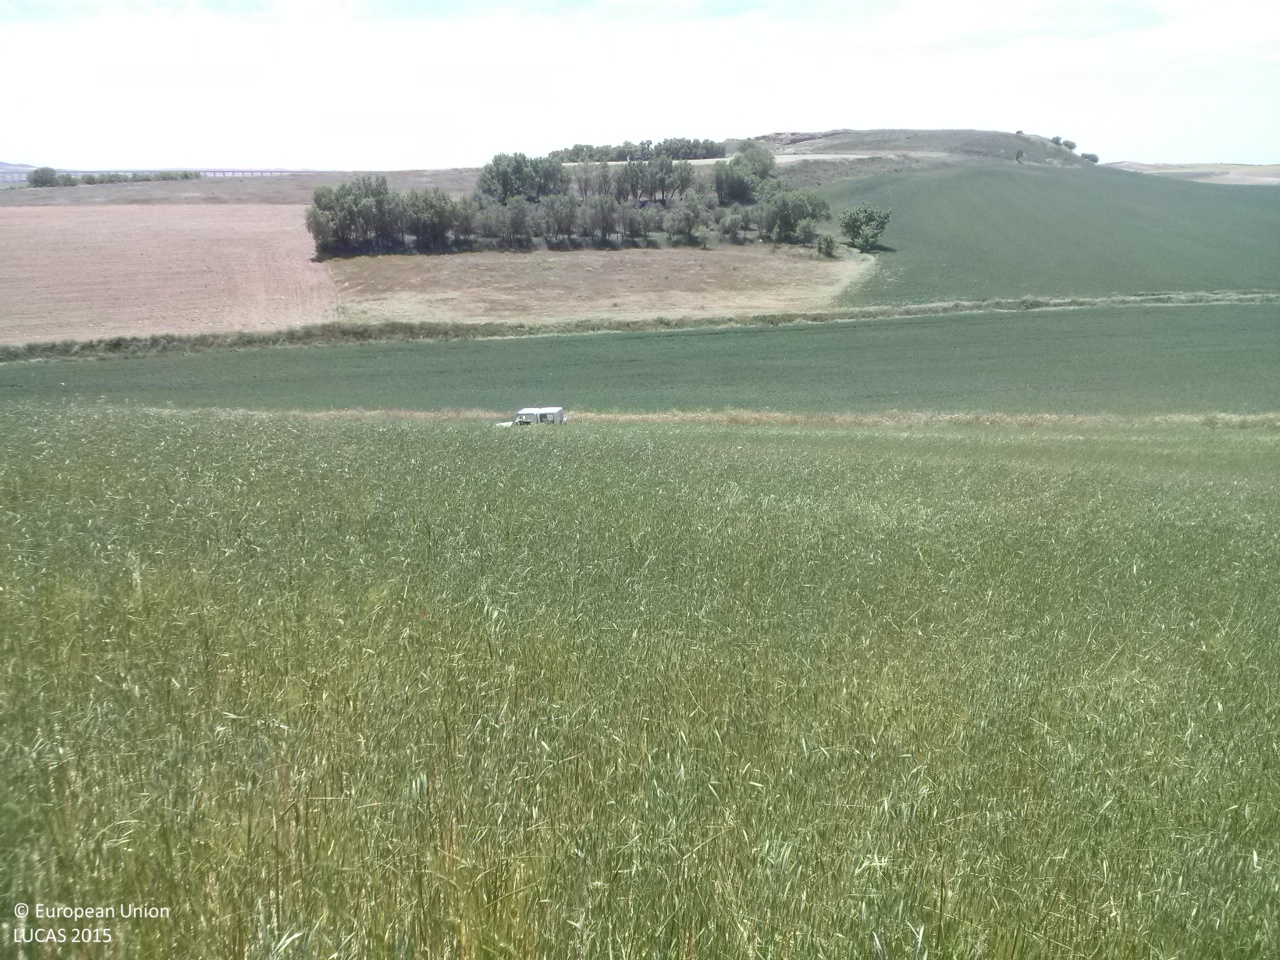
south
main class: Cropland
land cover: Mixed cereals for fodder
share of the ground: > 75 %
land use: Agriculture (excluding fallow land and kitchen gardens)
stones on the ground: < 10 %
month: May
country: ES
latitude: 39.9867
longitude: -2.7033
